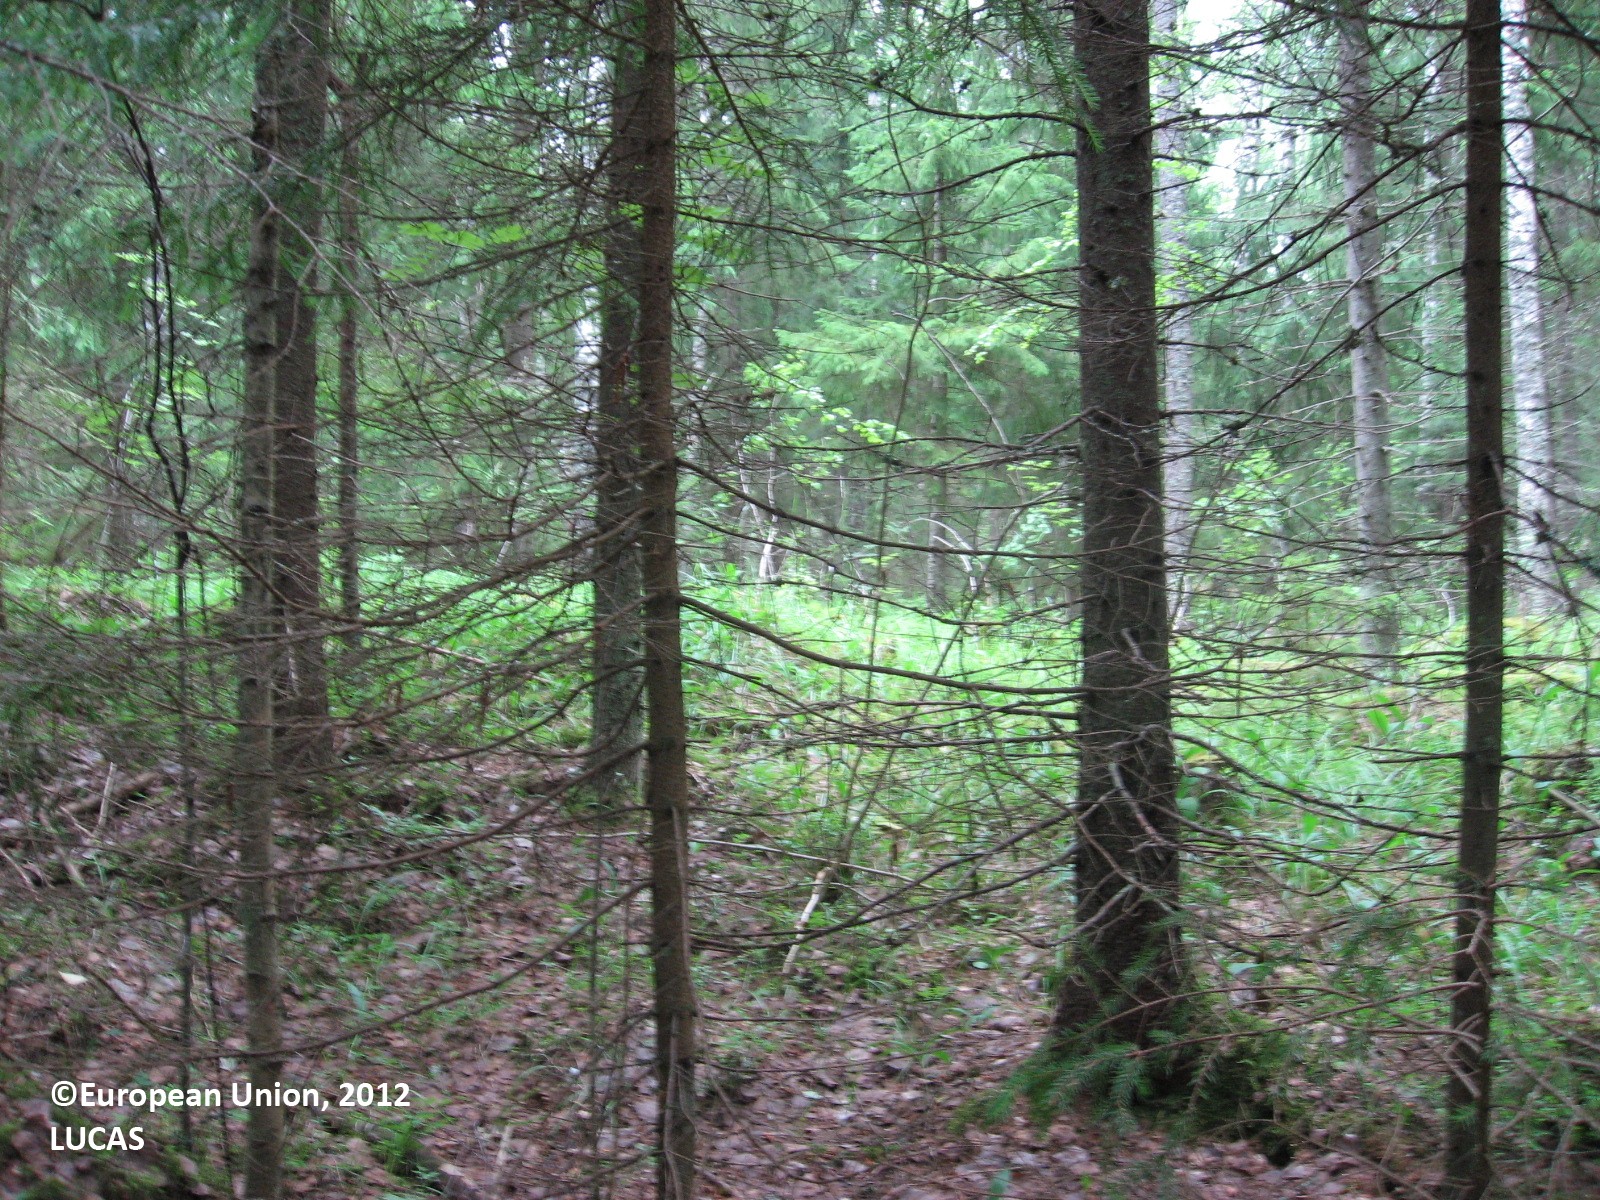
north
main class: Woodland
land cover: Spruce dominated mixed woodland
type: boreal forest
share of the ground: > 75 %
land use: Forestry
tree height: > 5 m
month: July
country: FI
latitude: 60.8019
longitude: 25.5461
